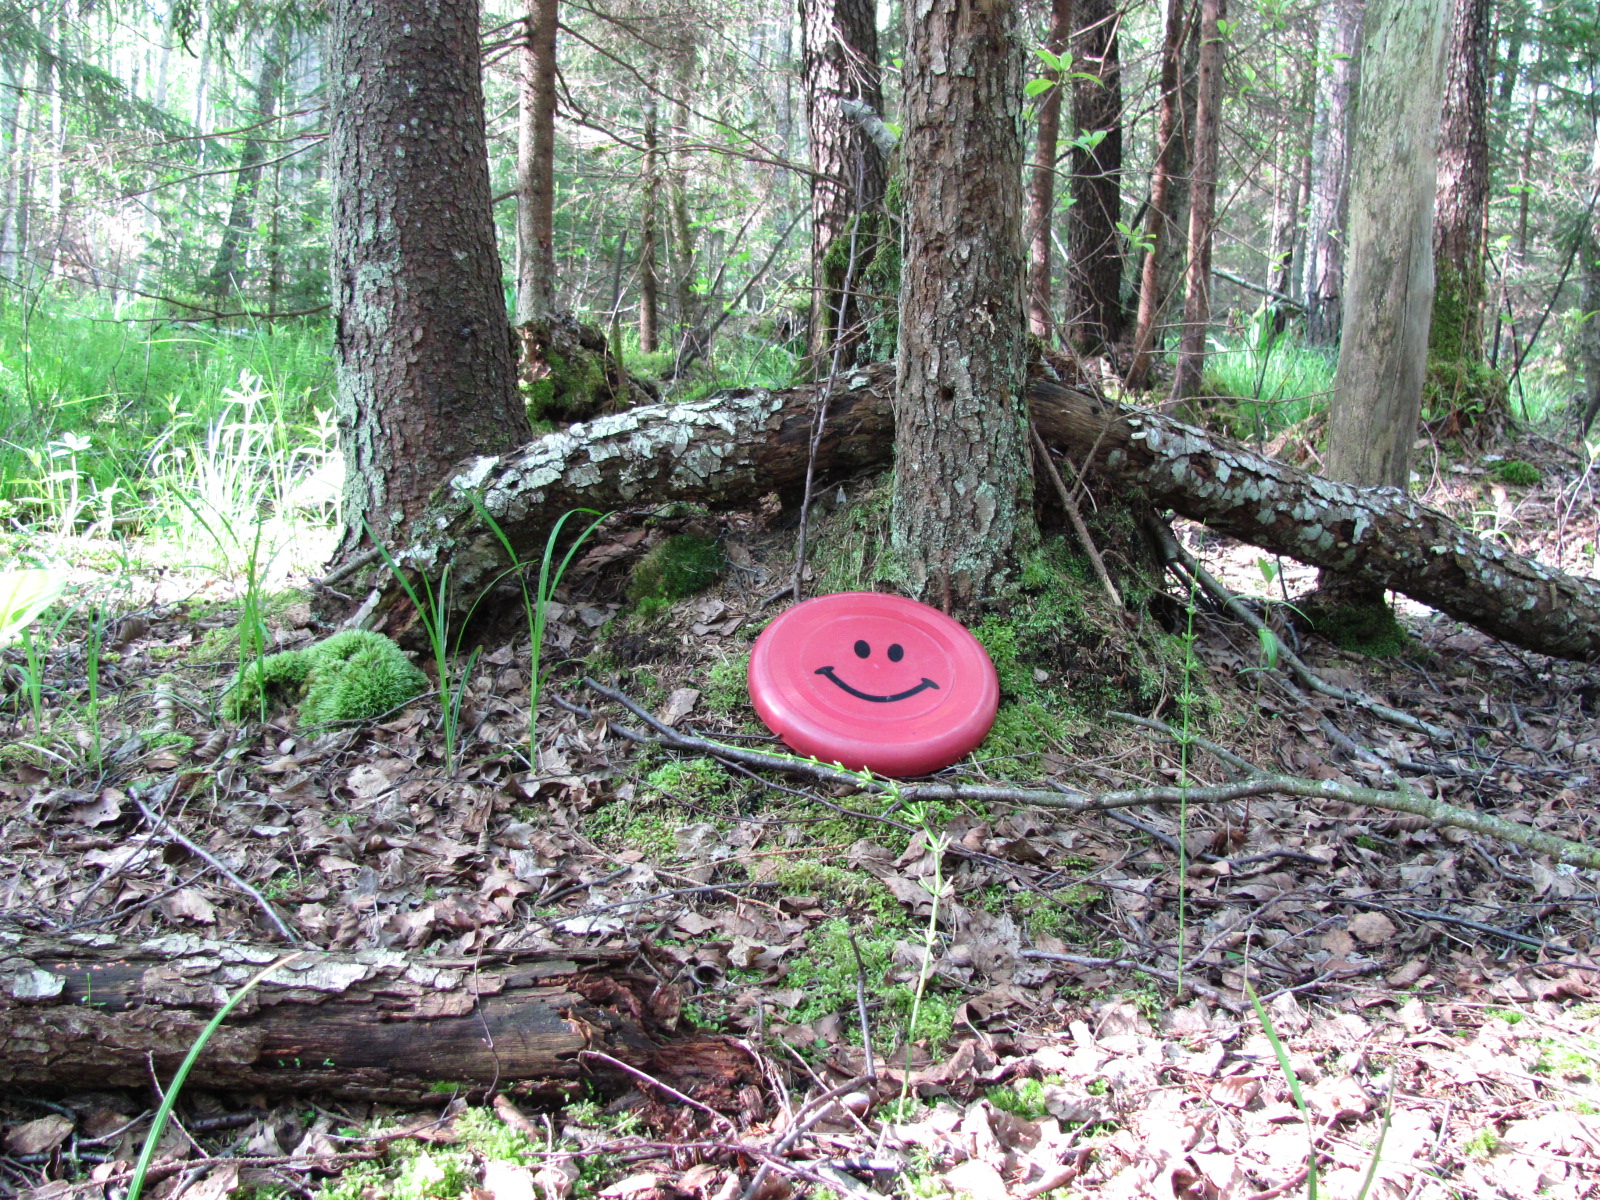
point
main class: Woodland
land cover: Spruce dominated mixed woodland
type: hemiboreal forest and nemoral coniferous forest and mixed broadleaved-coniferous forest
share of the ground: > 75 %
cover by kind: broadleaved forest trees 70 %, coniferous forest trees 30 %
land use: Forestry
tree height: > 5 m
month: May
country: LV
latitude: 56.6584
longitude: 24.1664
